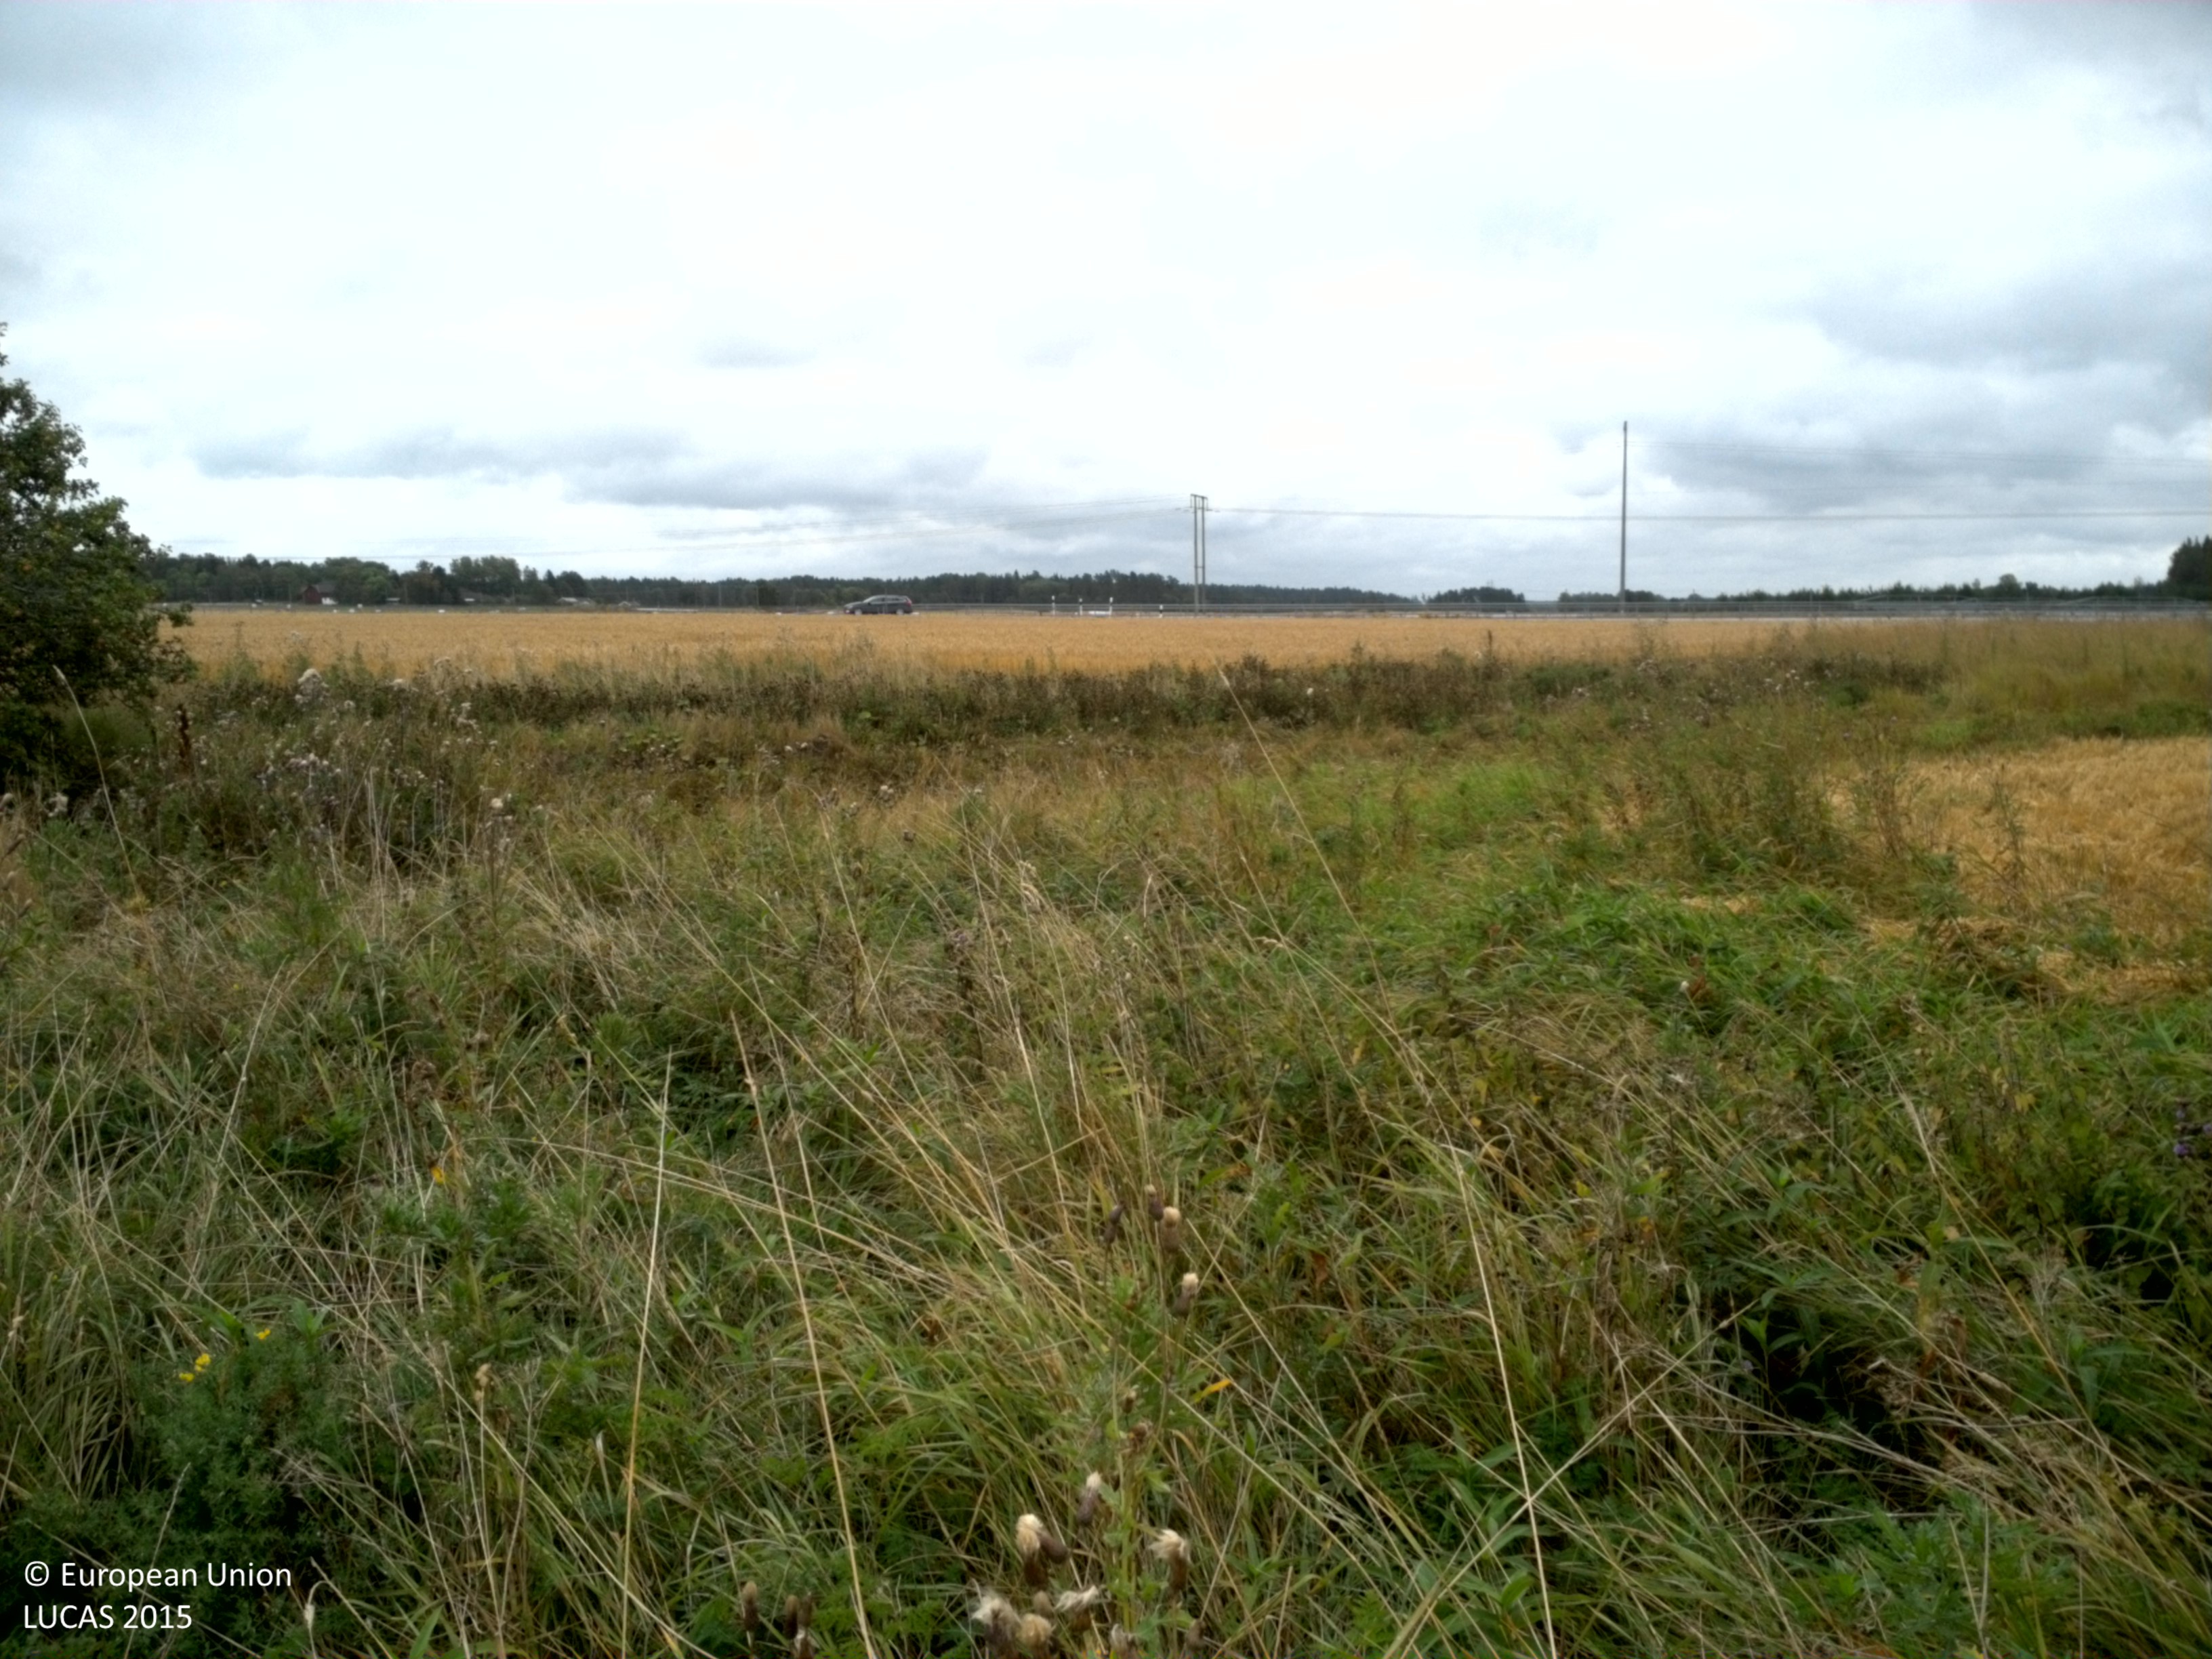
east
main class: Grassland
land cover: Grassland without tree/shrub cover
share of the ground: > 75 %
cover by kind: herbaceous plants 100 %
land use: Agriculture (excluding fallow land and kitchen gardens)
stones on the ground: < 10 %
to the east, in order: Grassland without tree/shrub cover; Ditches and canals; Grassland without tree/shrub cover; Ditches and canals; Grass margins; Common wheat; Fences; Ditches and canals; Grass margins; Paved roads, cycling and walking lanes; Grassland without tree/shrub cover; Paved roads, cycling and walking lanes; Grass margins; Ditches and canals; Fences; Grassland without tree/shrub cover; Paved roads, cycling and walking lanes; Grass margins; Inland fresh water bodies; Broadleaved woodland; Other leguminous and mixtures for fodder; Electric lines; Ditches and canals; Other leguminous and mixtures for fodder
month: August
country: SE
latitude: 59.9732
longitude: 17.6439
